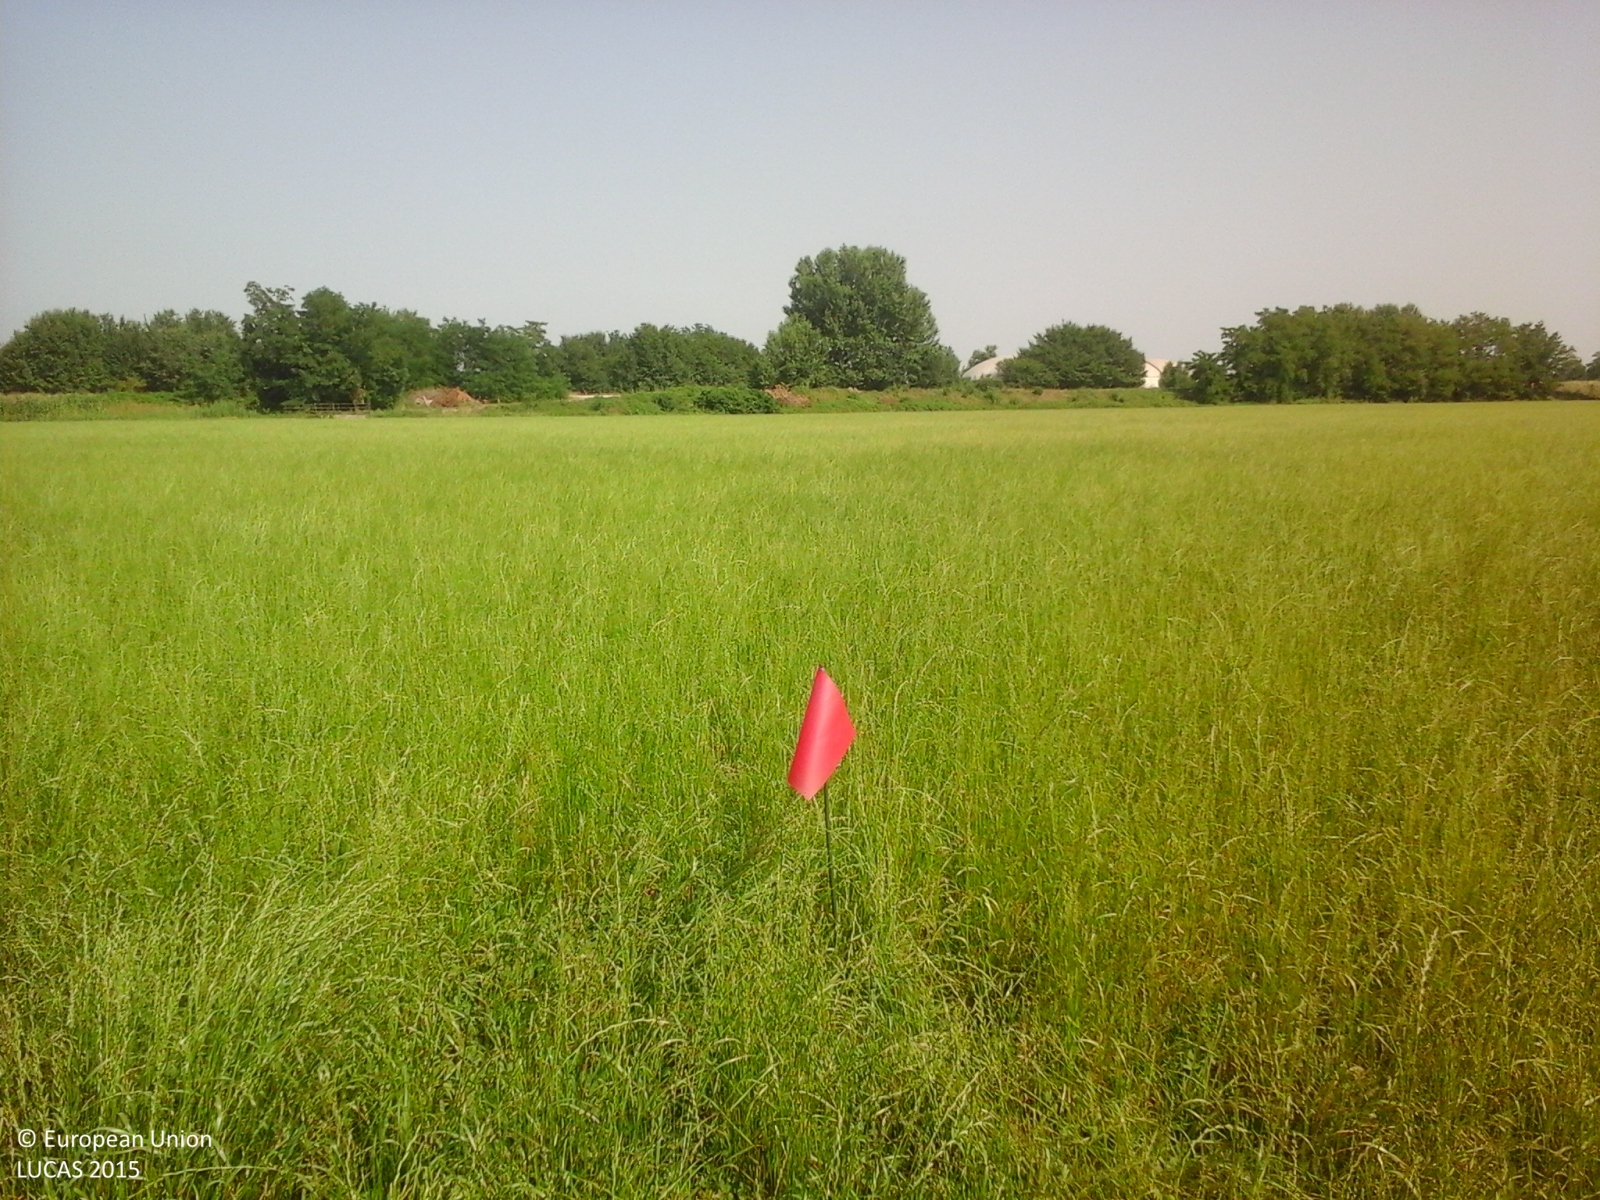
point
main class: Cropland
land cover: Temporary grasslands
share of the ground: > 75 %
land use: Agriculture (excluding fallow land and kitchen gardens)
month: July
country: IT
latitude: 45.2315
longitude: 10.7247
